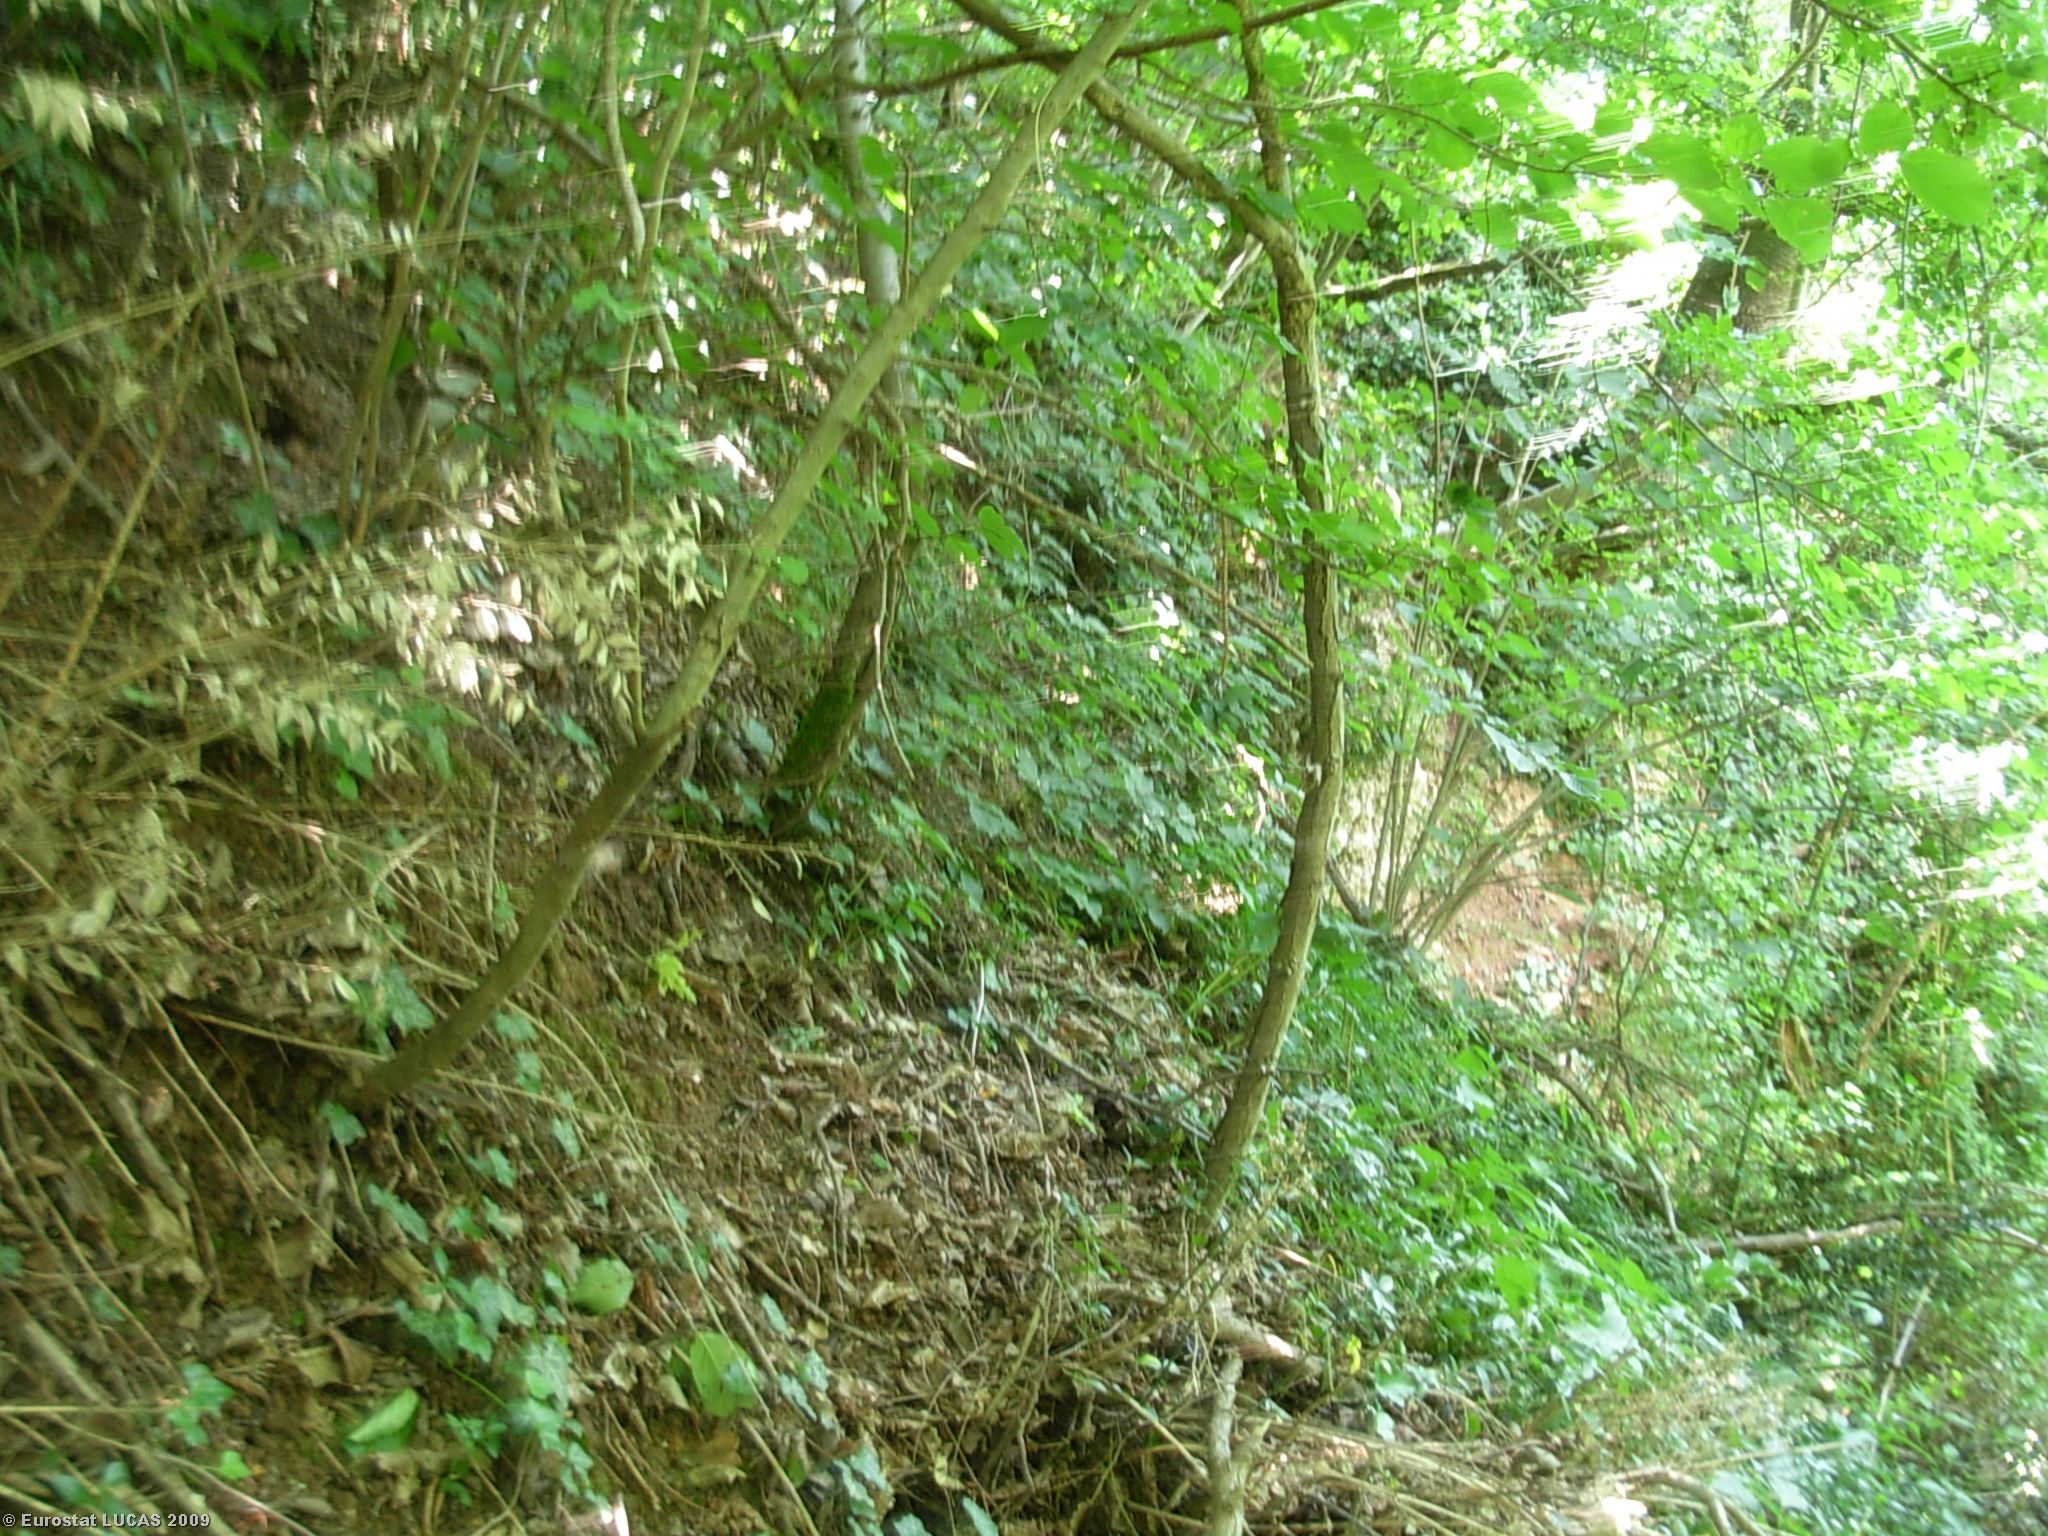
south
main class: Woodland
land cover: Broadleaved woodland
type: mountainous beech forest
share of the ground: > 75 %
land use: Unused
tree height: > 5 m
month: June
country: IT
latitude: 45.5575
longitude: 10.4476
